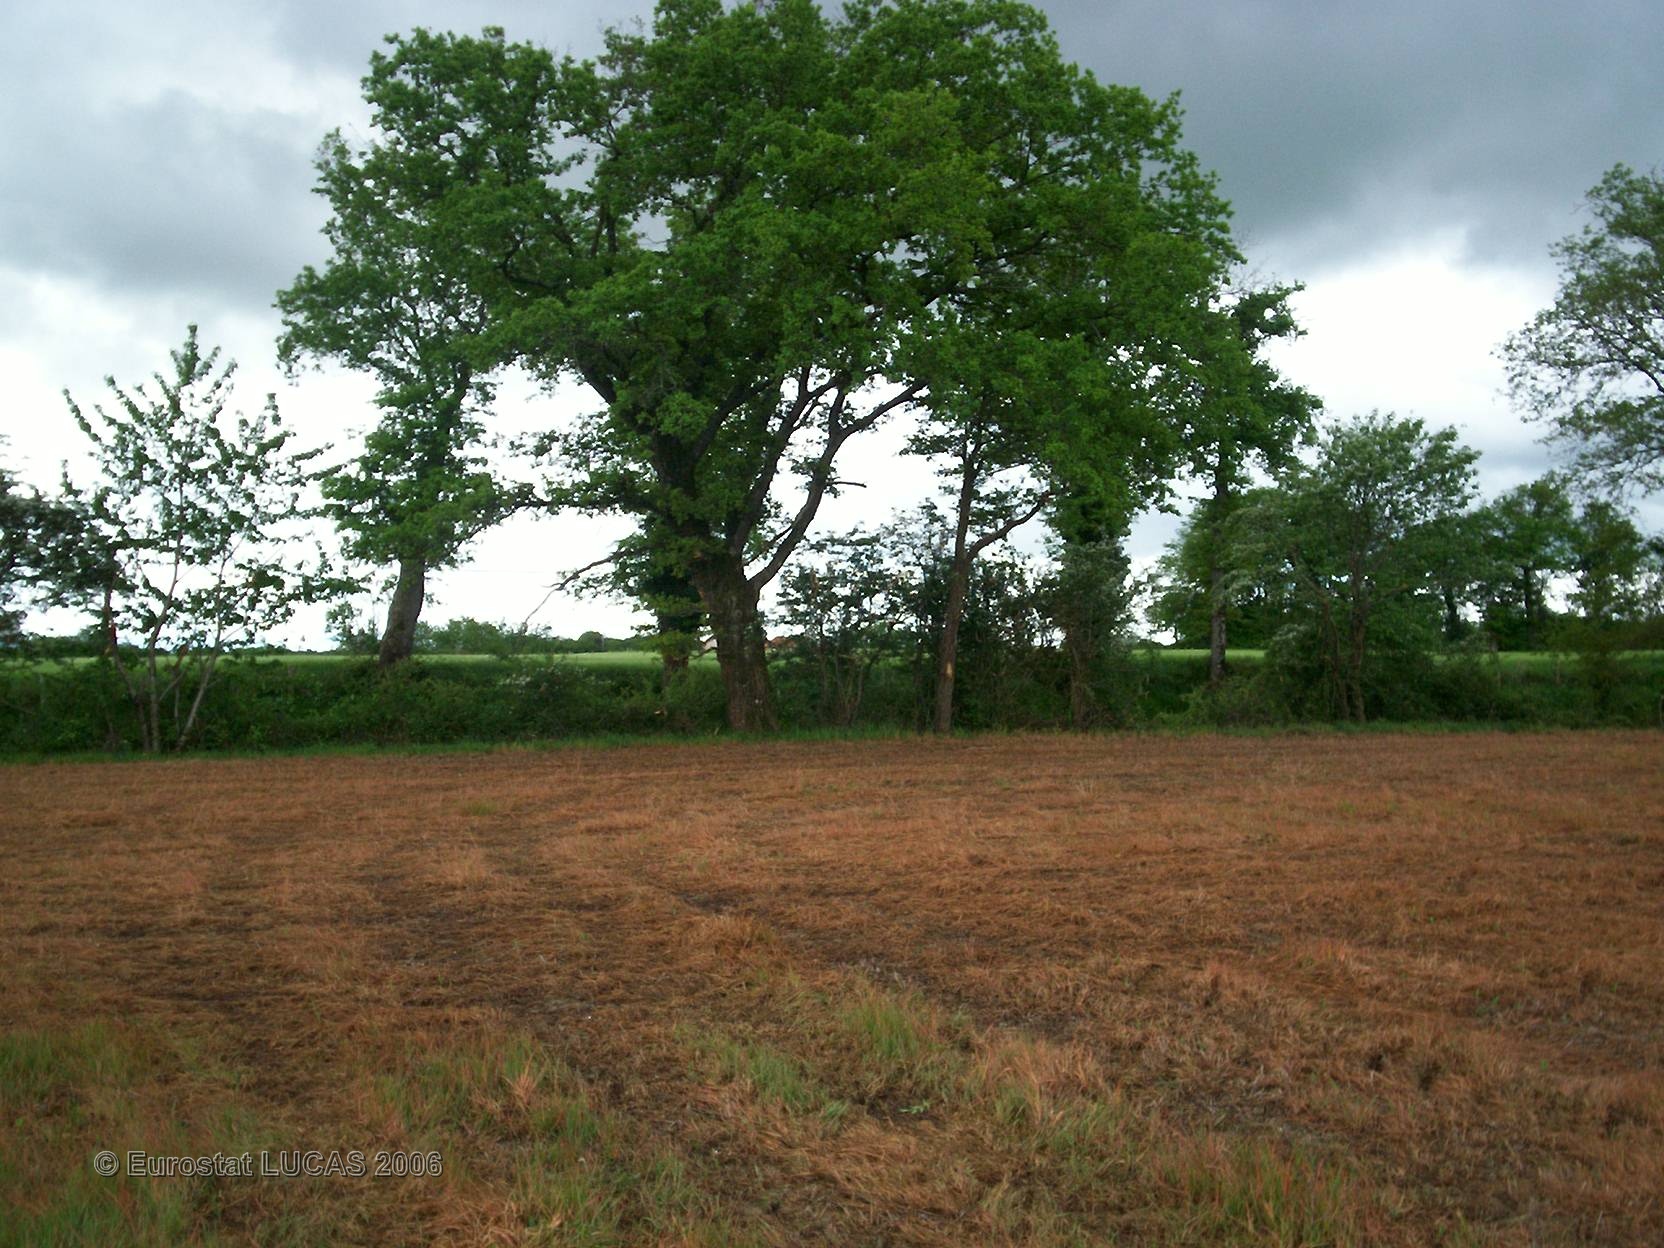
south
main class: Cropland
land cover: Maize
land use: Agriculture (excluding fallow land and kitchen gardens)
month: May
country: FR
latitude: 46.0174
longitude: 0.4910
